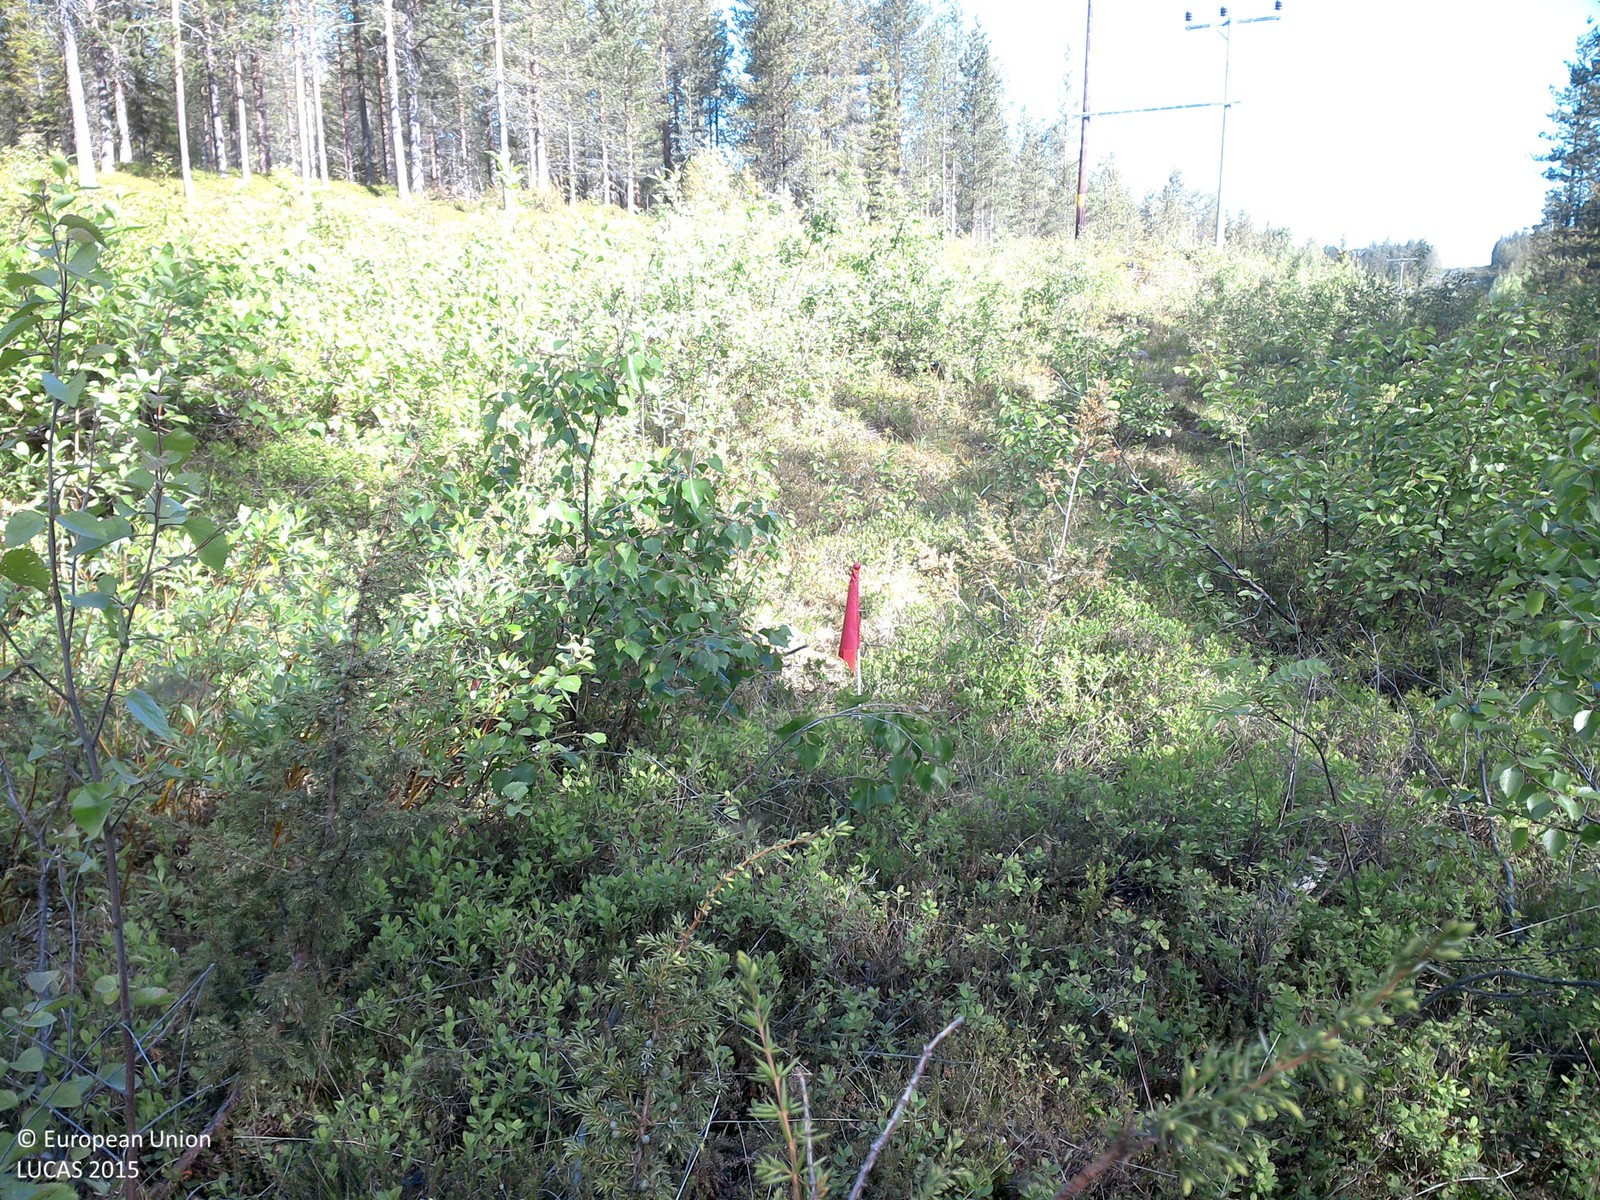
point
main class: Woodland
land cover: Broadleaved woodland
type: boreal forest
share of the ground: 10 - 25 %
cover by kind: shrubs 70 %, broadleaved forest trees 15 %, lichens and mosses 10 %, herbaceous plants 5 %
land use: Community services
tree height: < 5 m
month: June
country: SE
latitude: 66.8544
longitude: 23.0364
